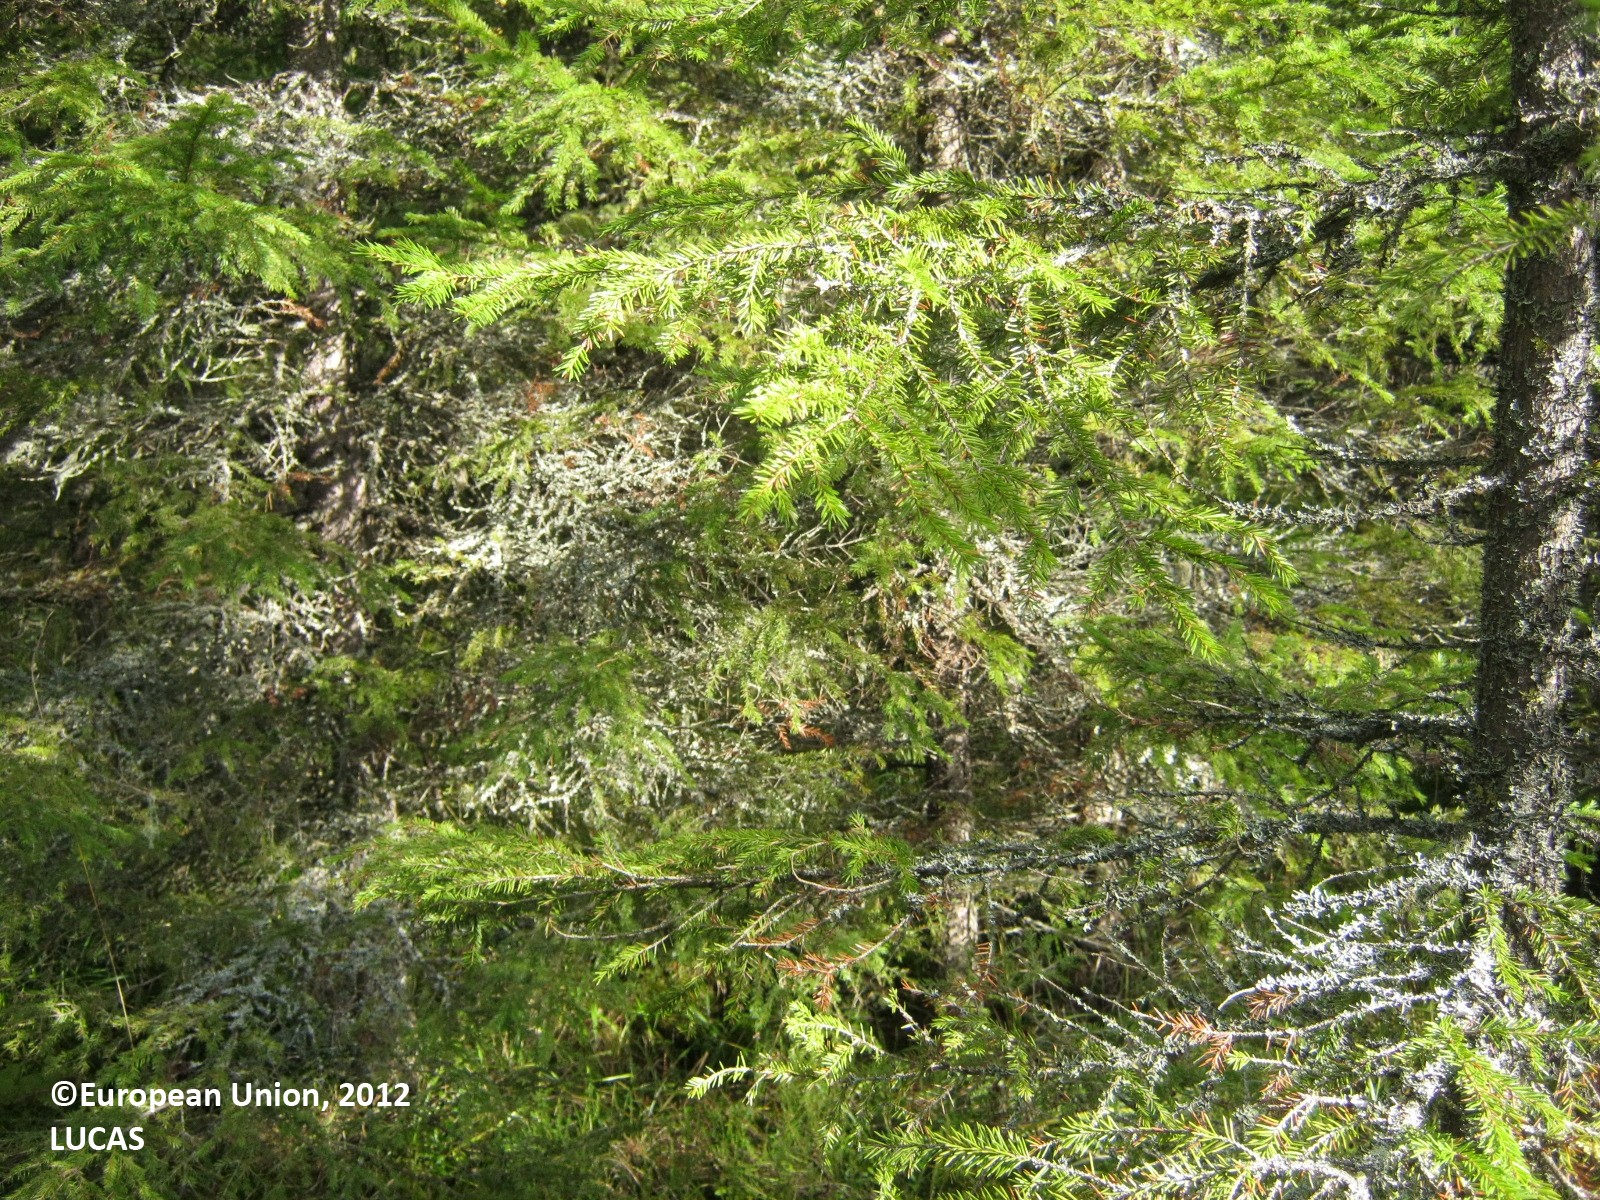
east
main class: Woodland
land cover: Spruce dominated coniferous woodland
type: boreal forest
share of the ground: > 75 %
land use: Forestry
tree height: > 5 m
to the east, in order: Spruce dominated coniferous woodland; Ditches and canals; Grass margins; Paved roads, cycling and walking lanes; Shruby margins; Ditches and canals; Other bare soil; Shrubland without tree cover
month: September
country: FI
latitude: 62.2526
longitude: 28.9143
